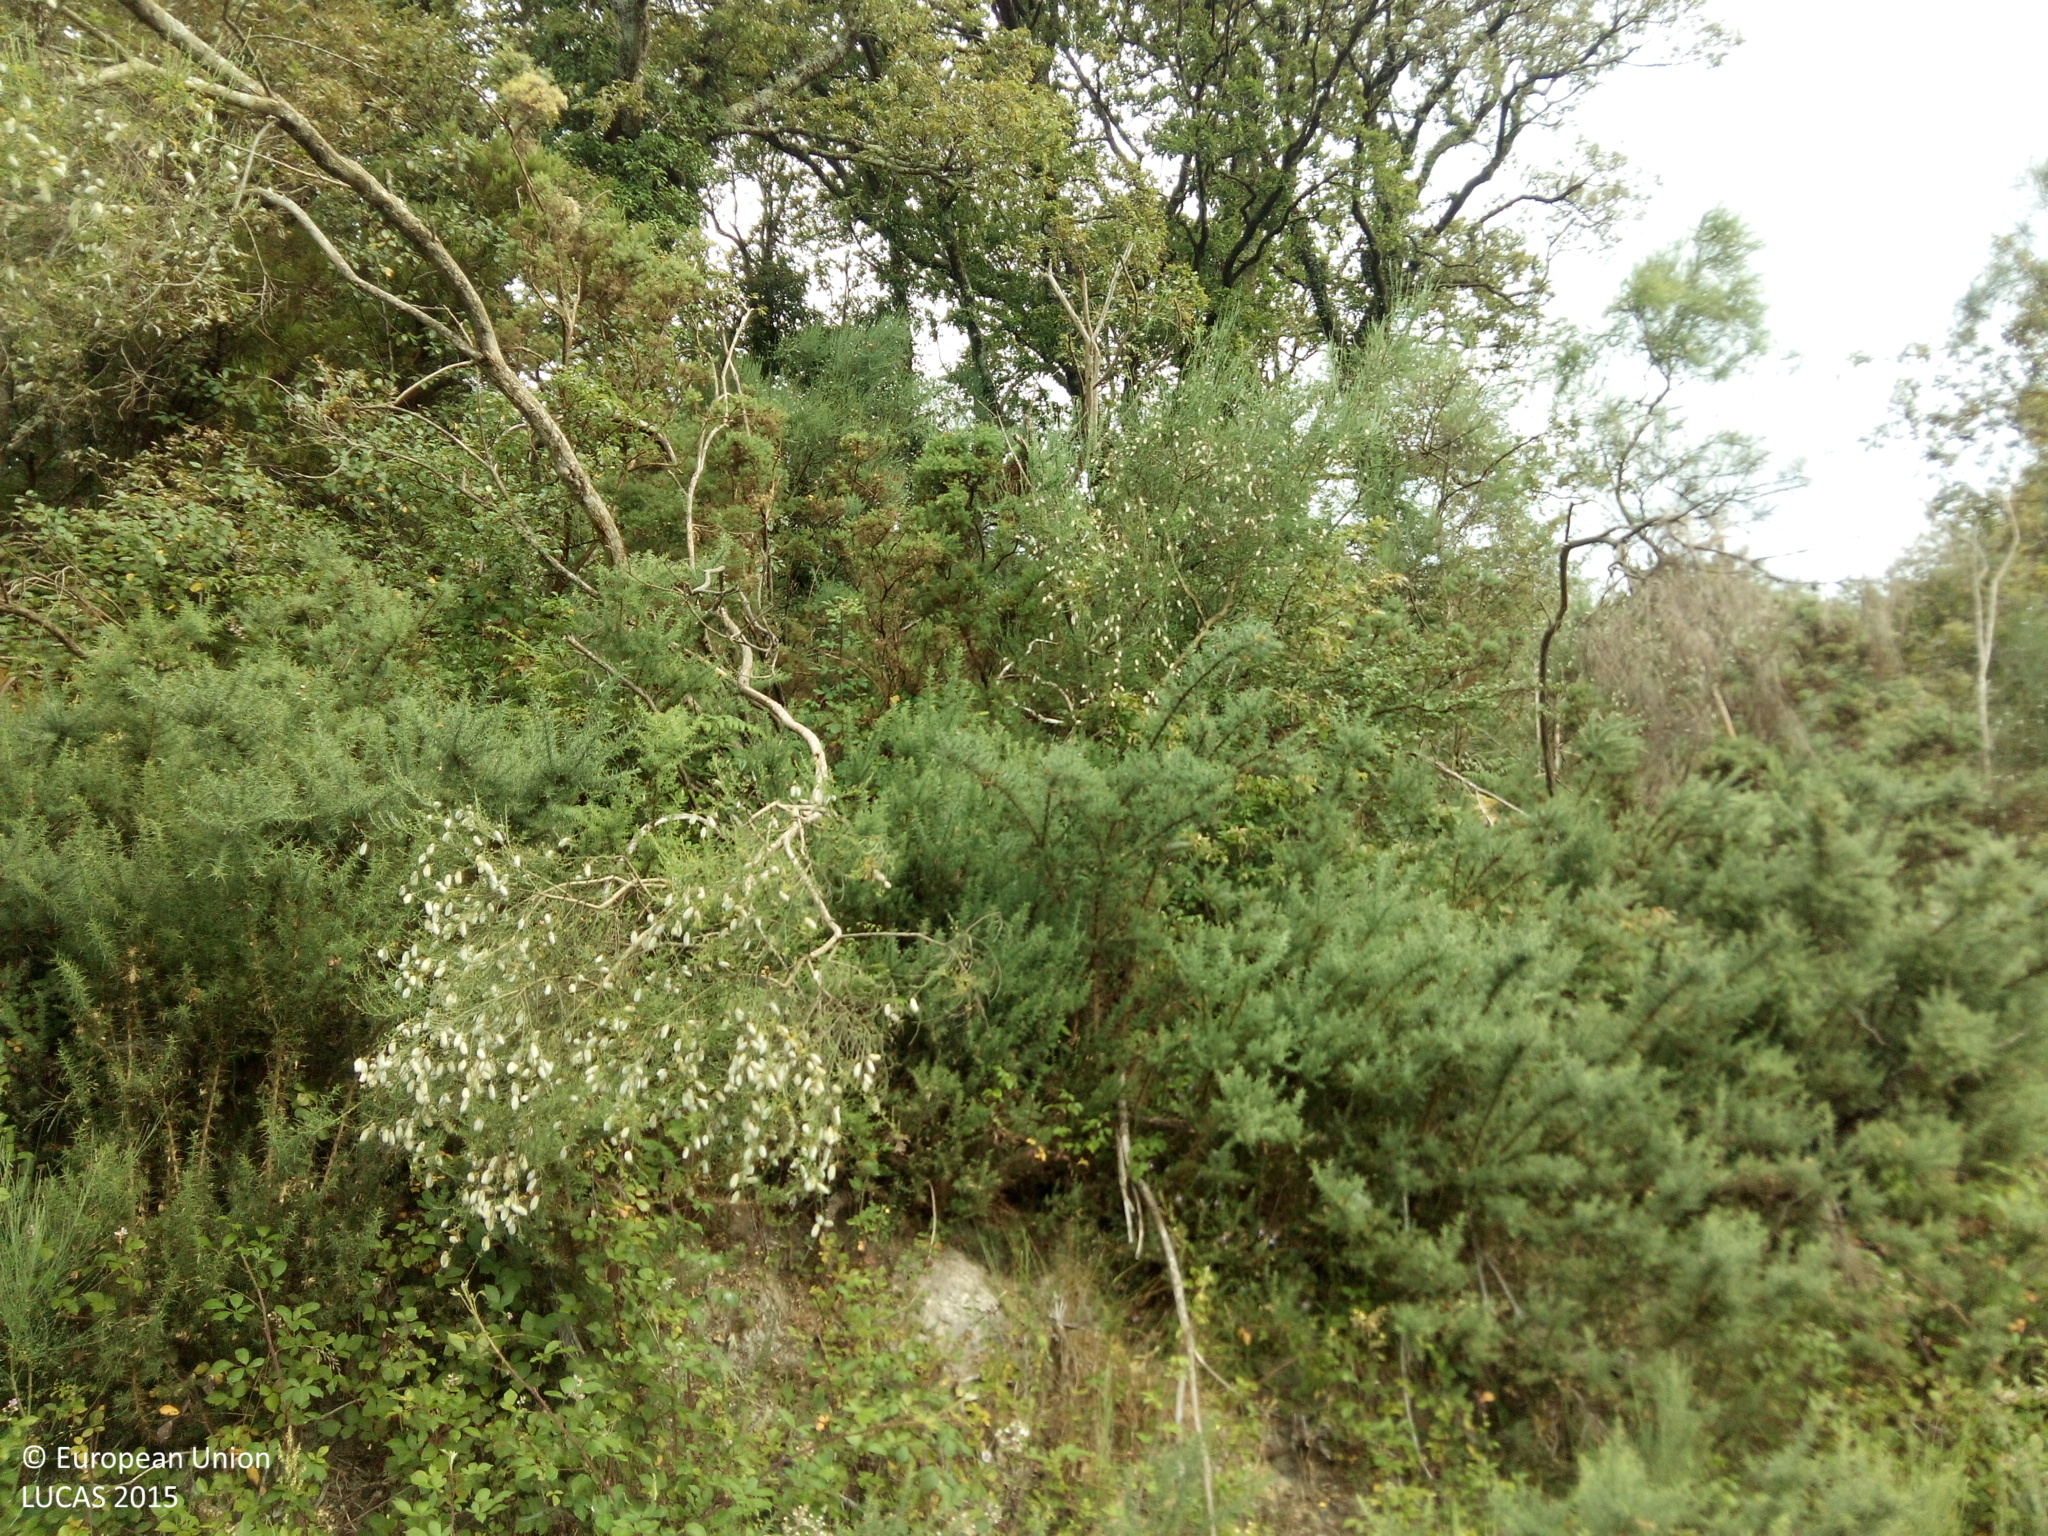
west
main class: Woodland
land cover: Broadleaved woodland
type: broadleaved evergreen forest
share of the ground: > 75 %
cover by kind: broadleaved forest trees 100 %
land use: Semi-natural and natural areas not in use
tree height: > 5 m
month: July
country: ES
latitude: 42.3004
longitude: -8.2963
